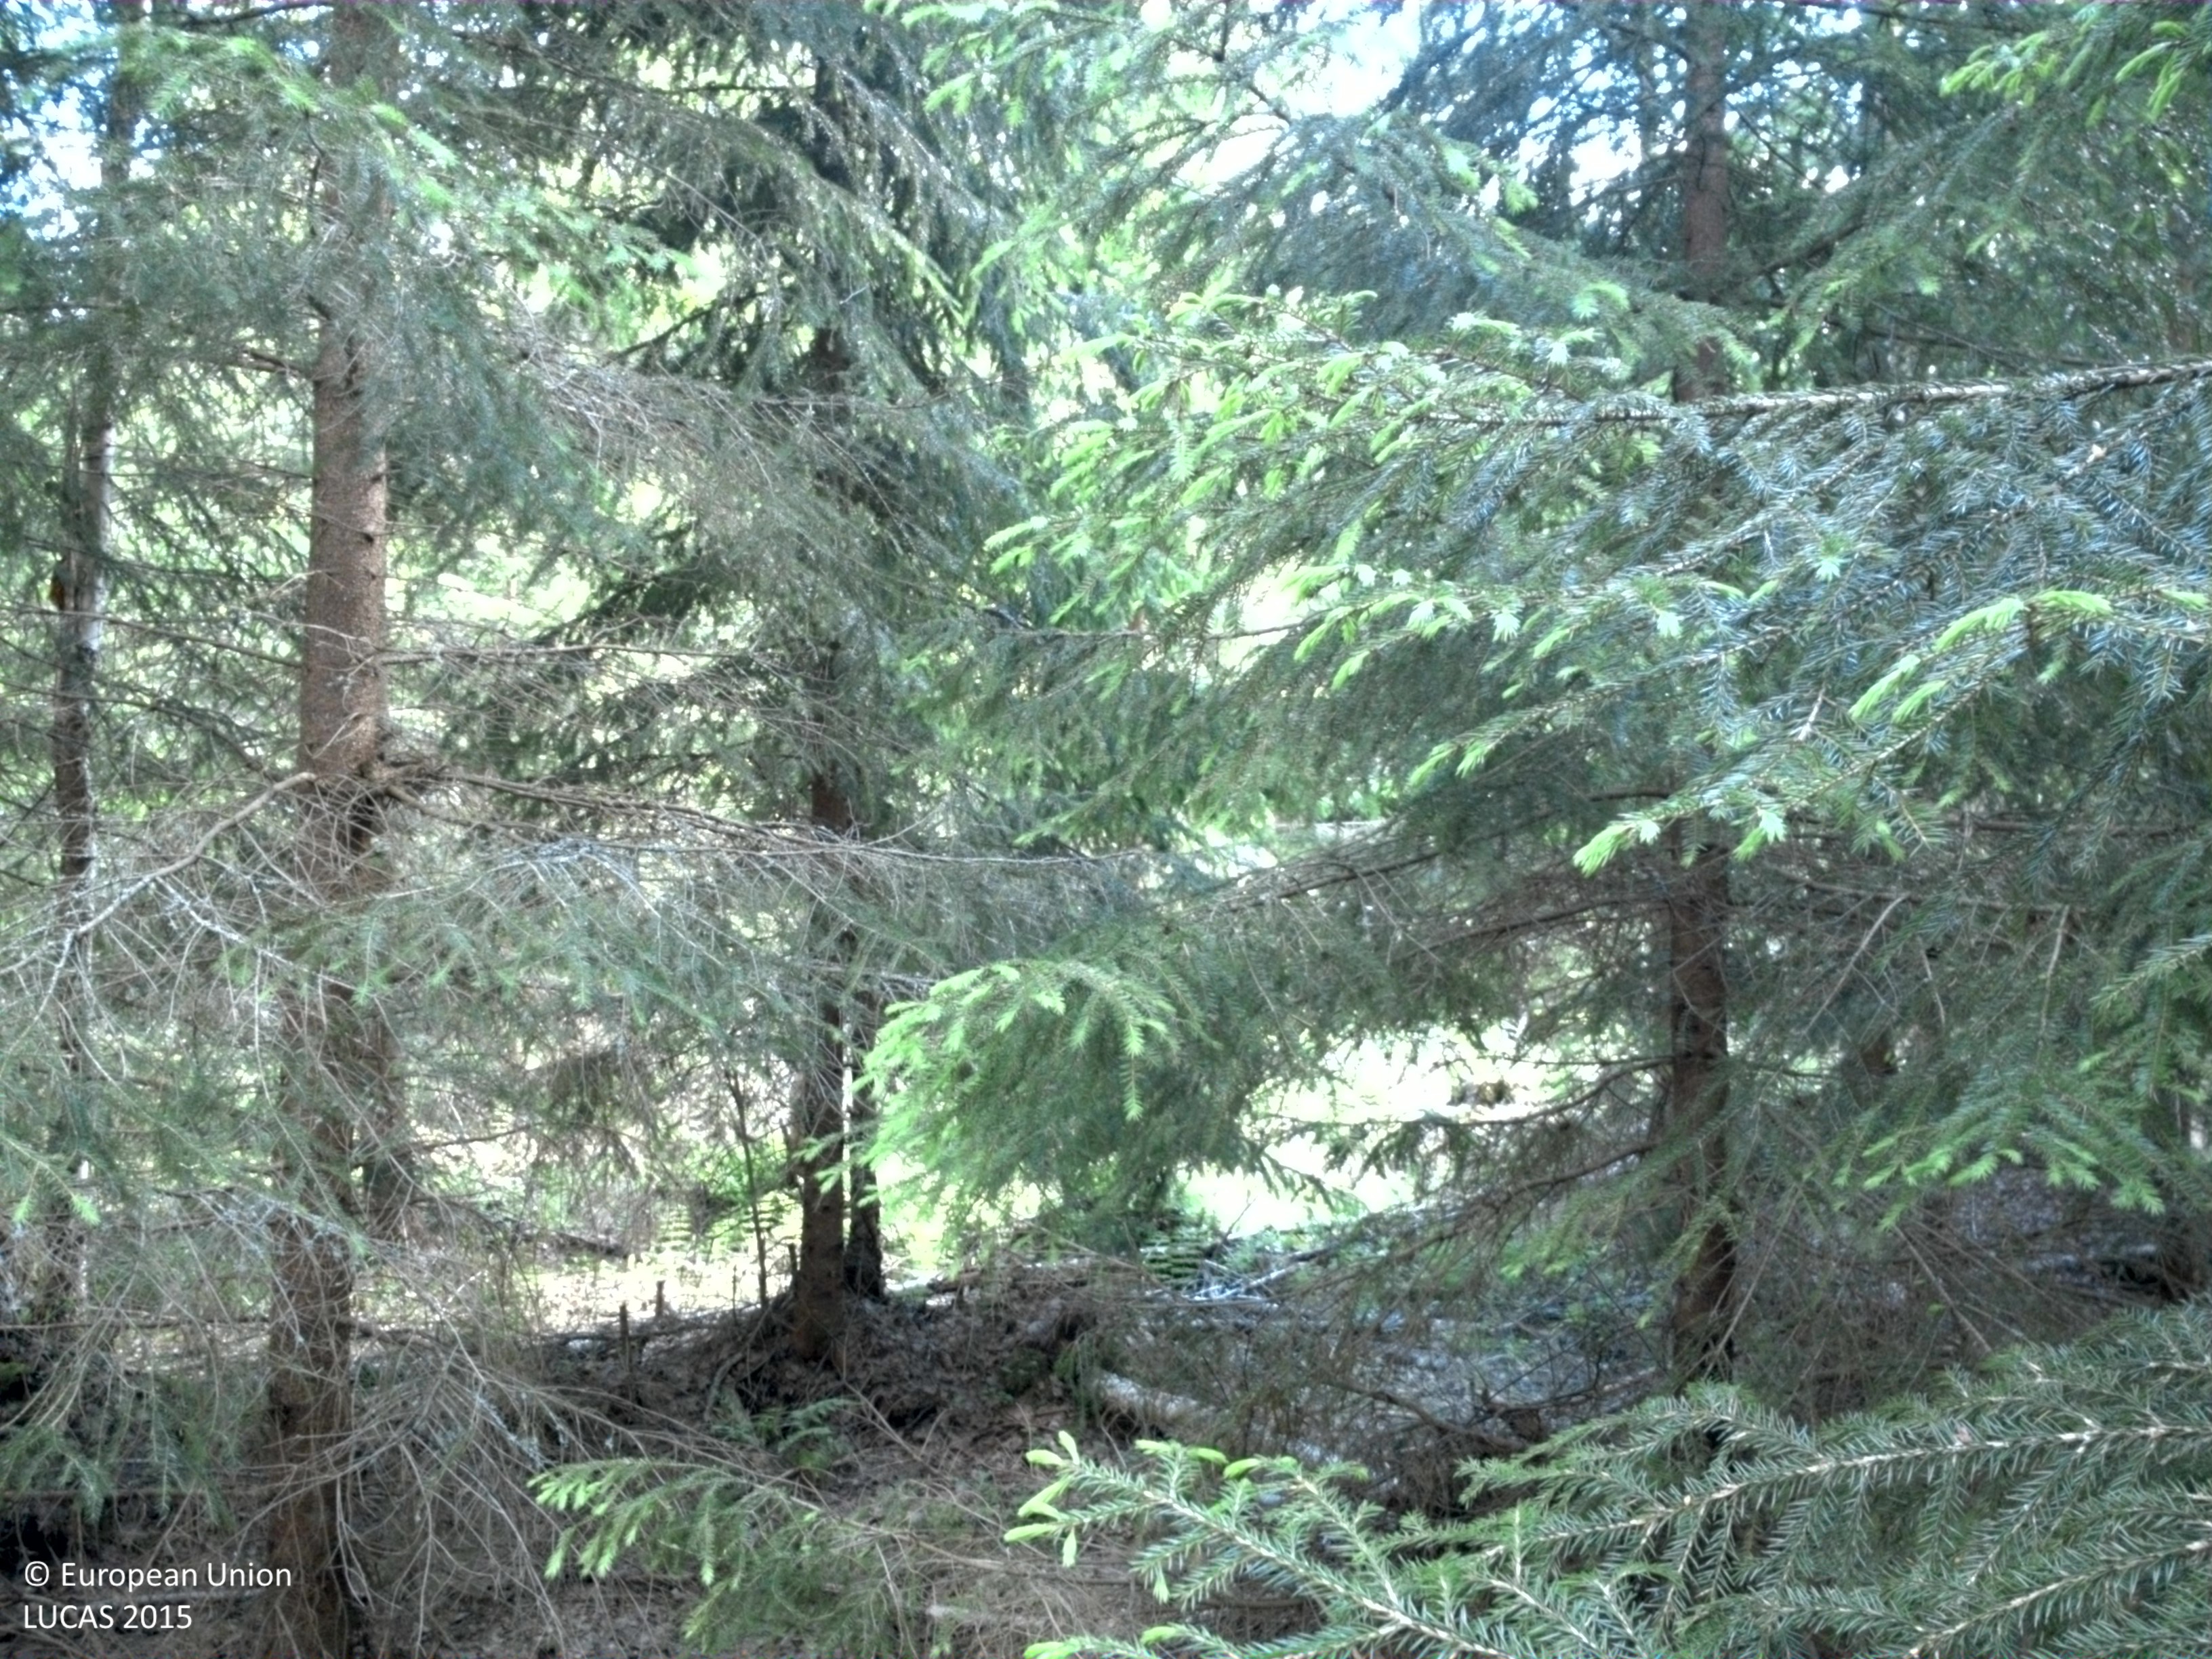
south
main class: Woodland
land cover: Spruce dominated mixed woodland
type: hemiboreal forest and nemoral coniferous forest and mixed broadleaved-coniferous forest
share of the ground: > 75 %
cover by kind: coniferous forest trees 50 %, broadleaved forest trees 30 %, lichens and mosses 20 %
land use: Forestry
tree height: > 5 m
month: June
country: SE
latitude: 60.2178
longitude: 17.1204
